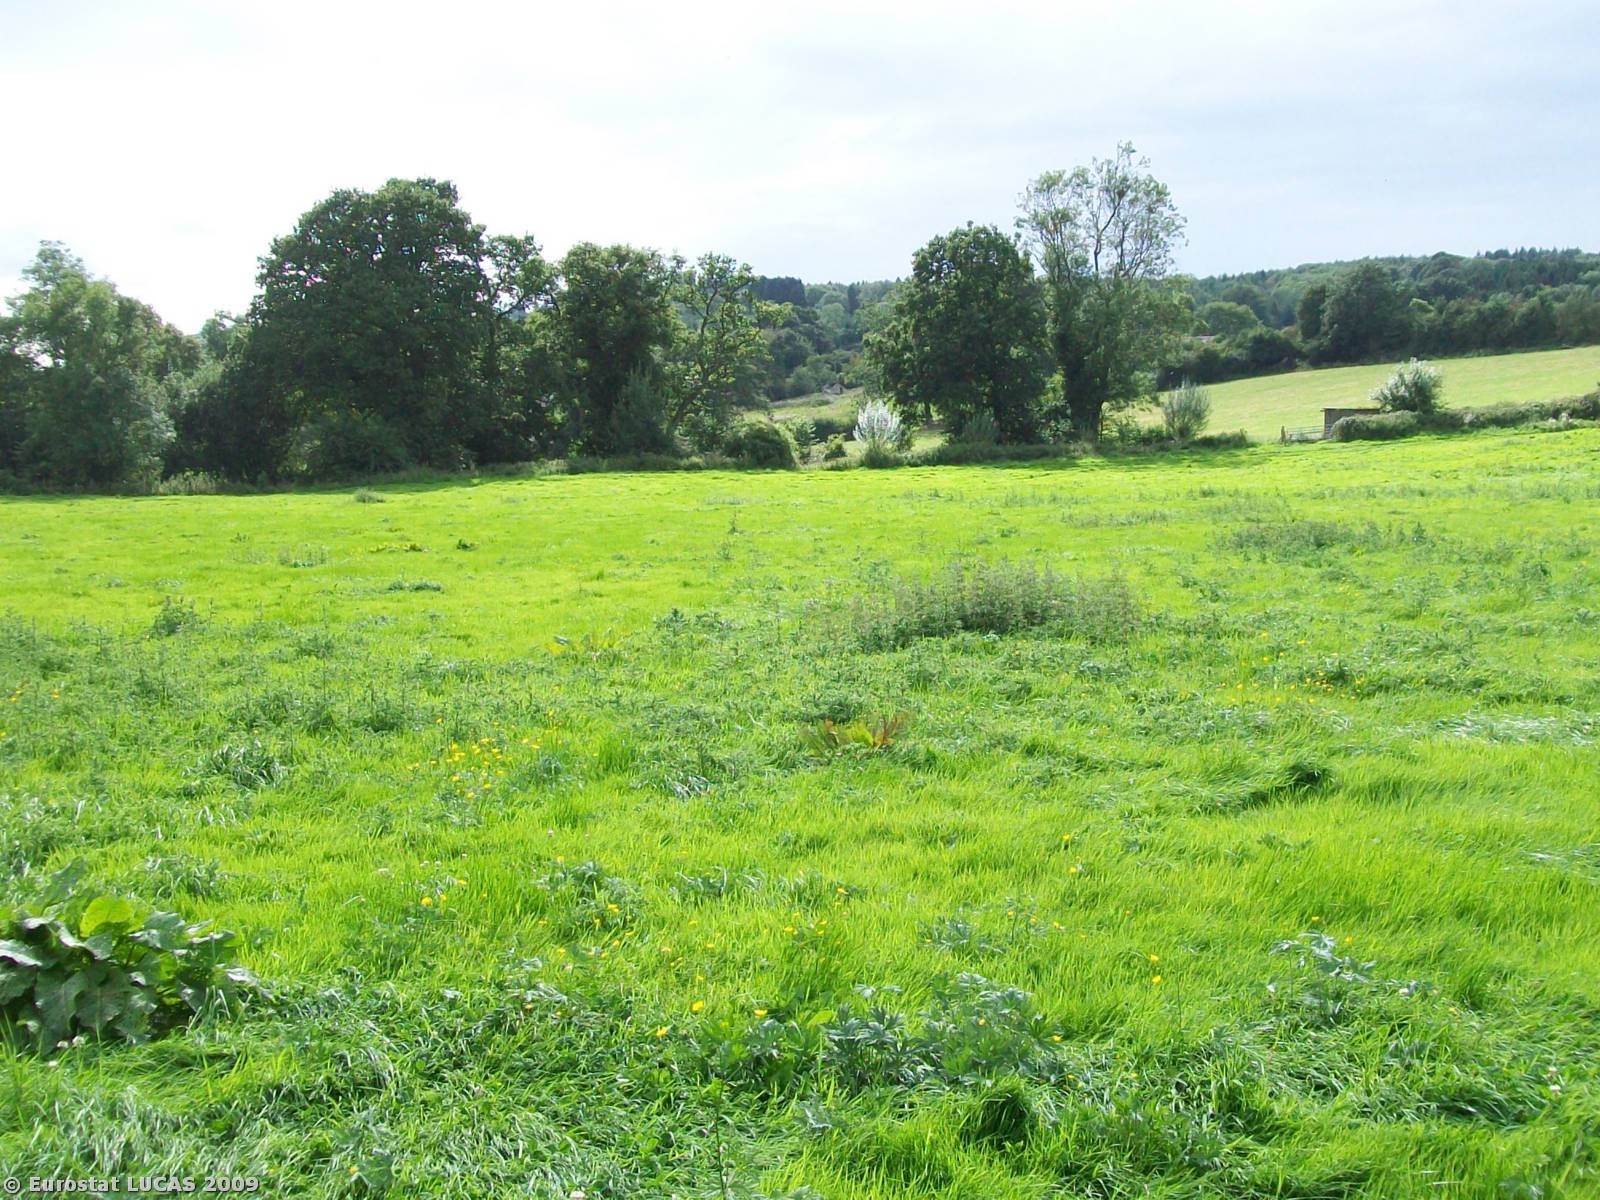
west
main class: Grassland
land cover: Grassland without tree/shrub cover
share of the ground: > 75 %
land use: Agriculture (excluding fallow land and kitchen gardens)
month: August
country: GB
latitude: 51.8879
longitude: -2.4004
